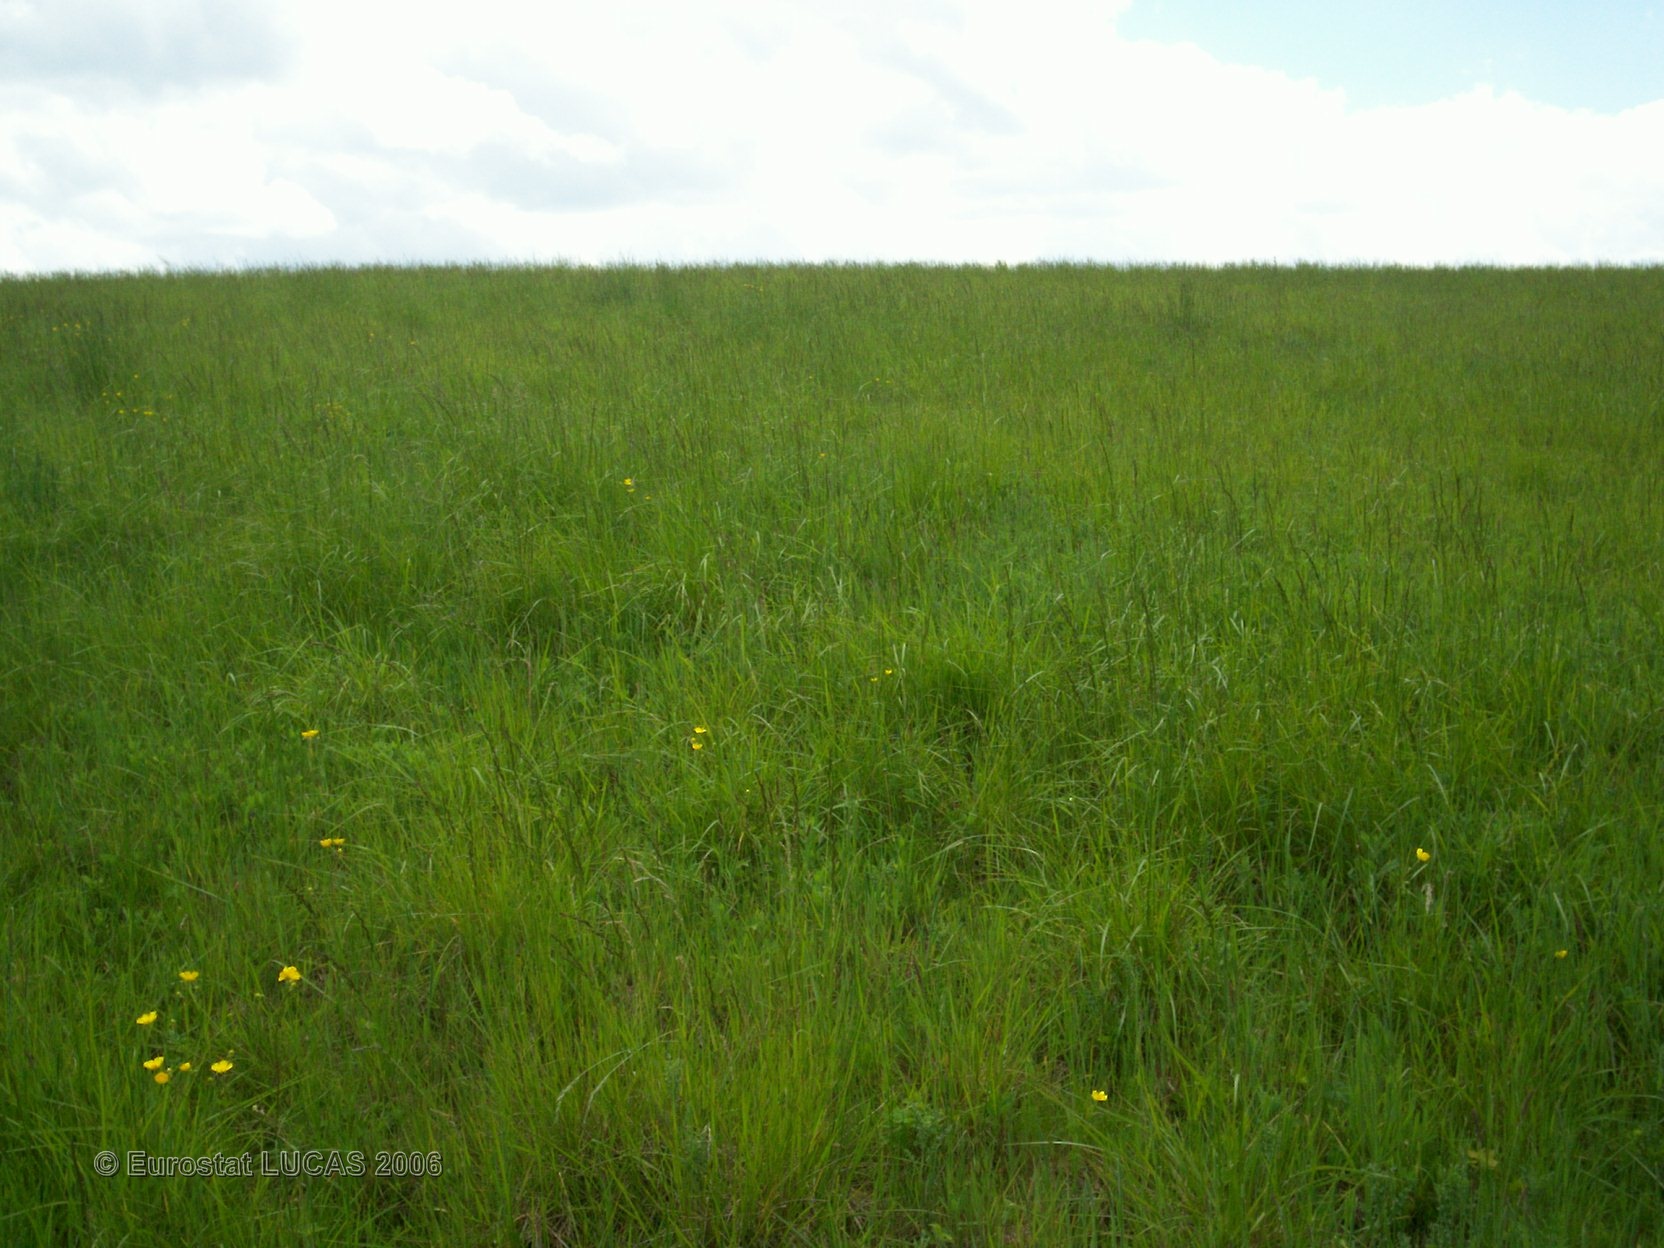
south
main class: Grassland
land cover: Grassland without tree/shrub cover
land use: Agriculture (excluding fallow land and kitchen gardens)
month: May
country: FR
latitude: 48.3291
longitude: 4.6700
